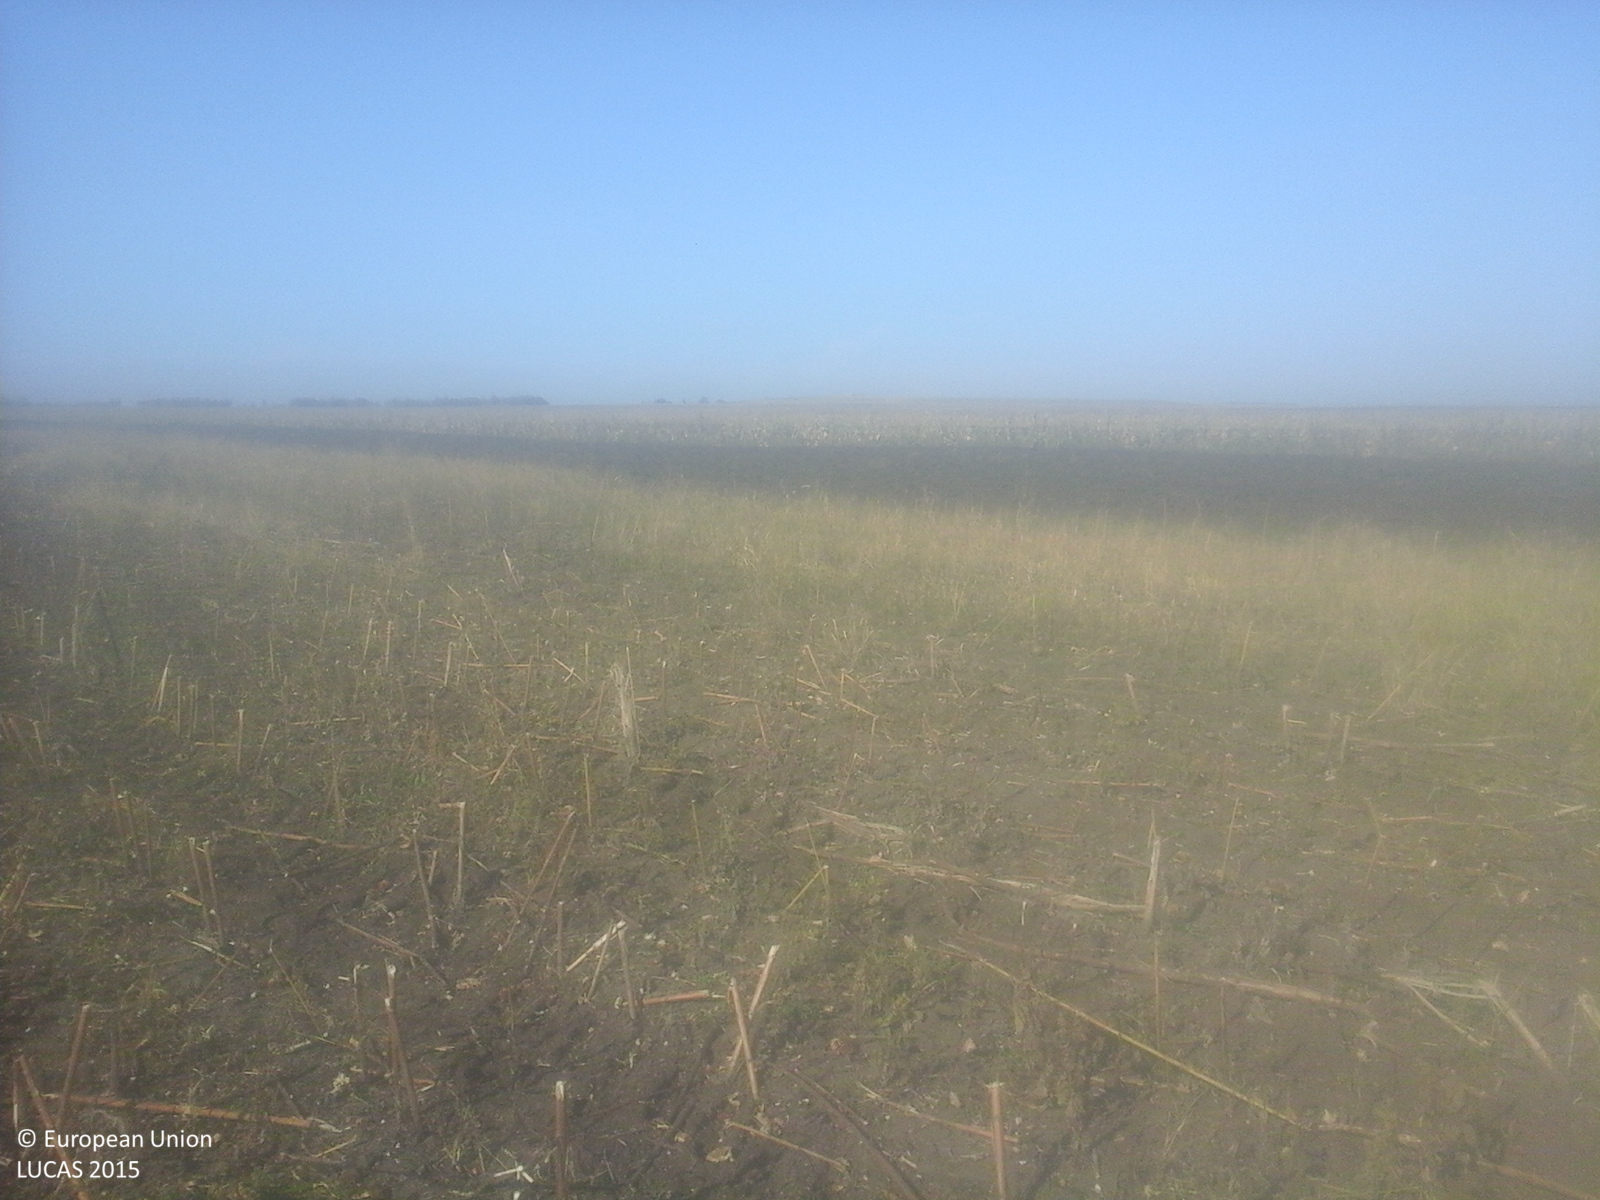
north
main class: Cropland
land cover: Sunflower
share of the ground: 25 - 50 %
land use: Agriculture (excluding fallow land and kitchen gardens)
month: October
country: RO
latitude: 45.3230
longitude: 26.9113
